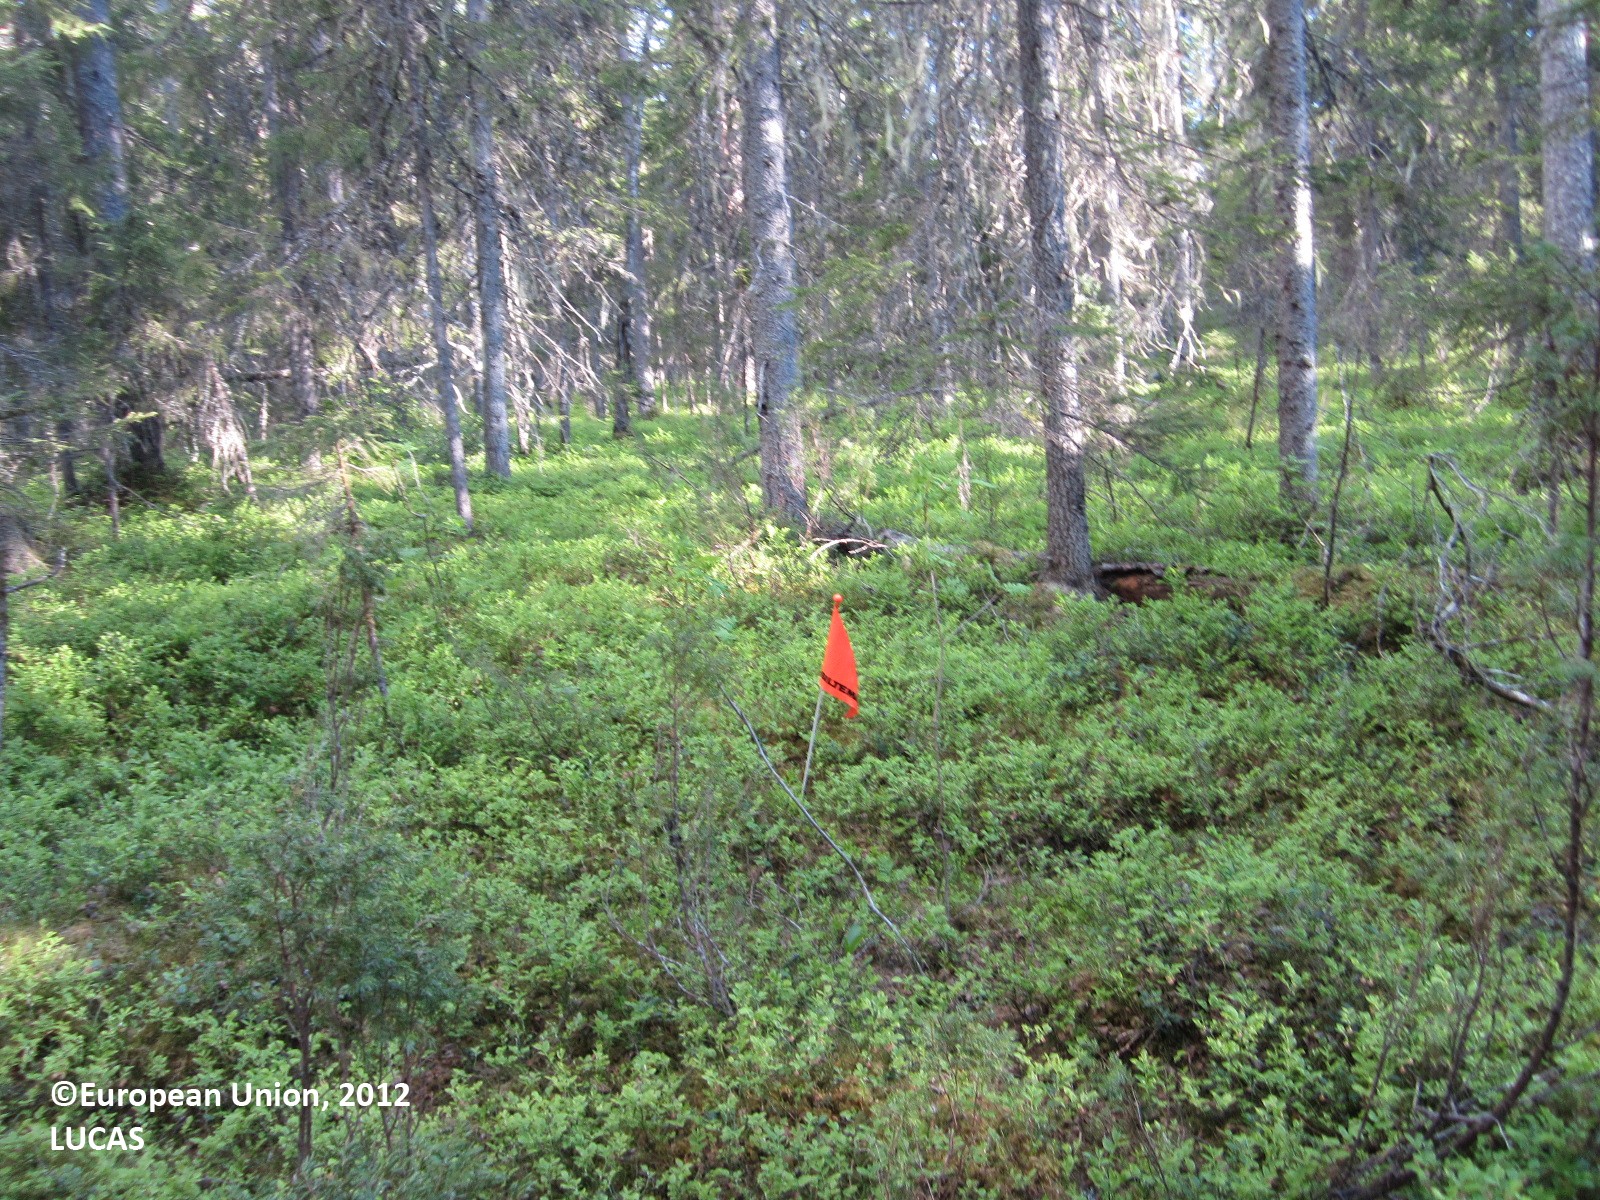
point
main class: Woodland
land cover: Spruce dominated coniferous woodland
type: boreal forest
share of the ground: > 75 %
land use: Forestry
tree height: > 5 m
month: June
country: FI
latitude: 64.7036
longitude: 28.7444
